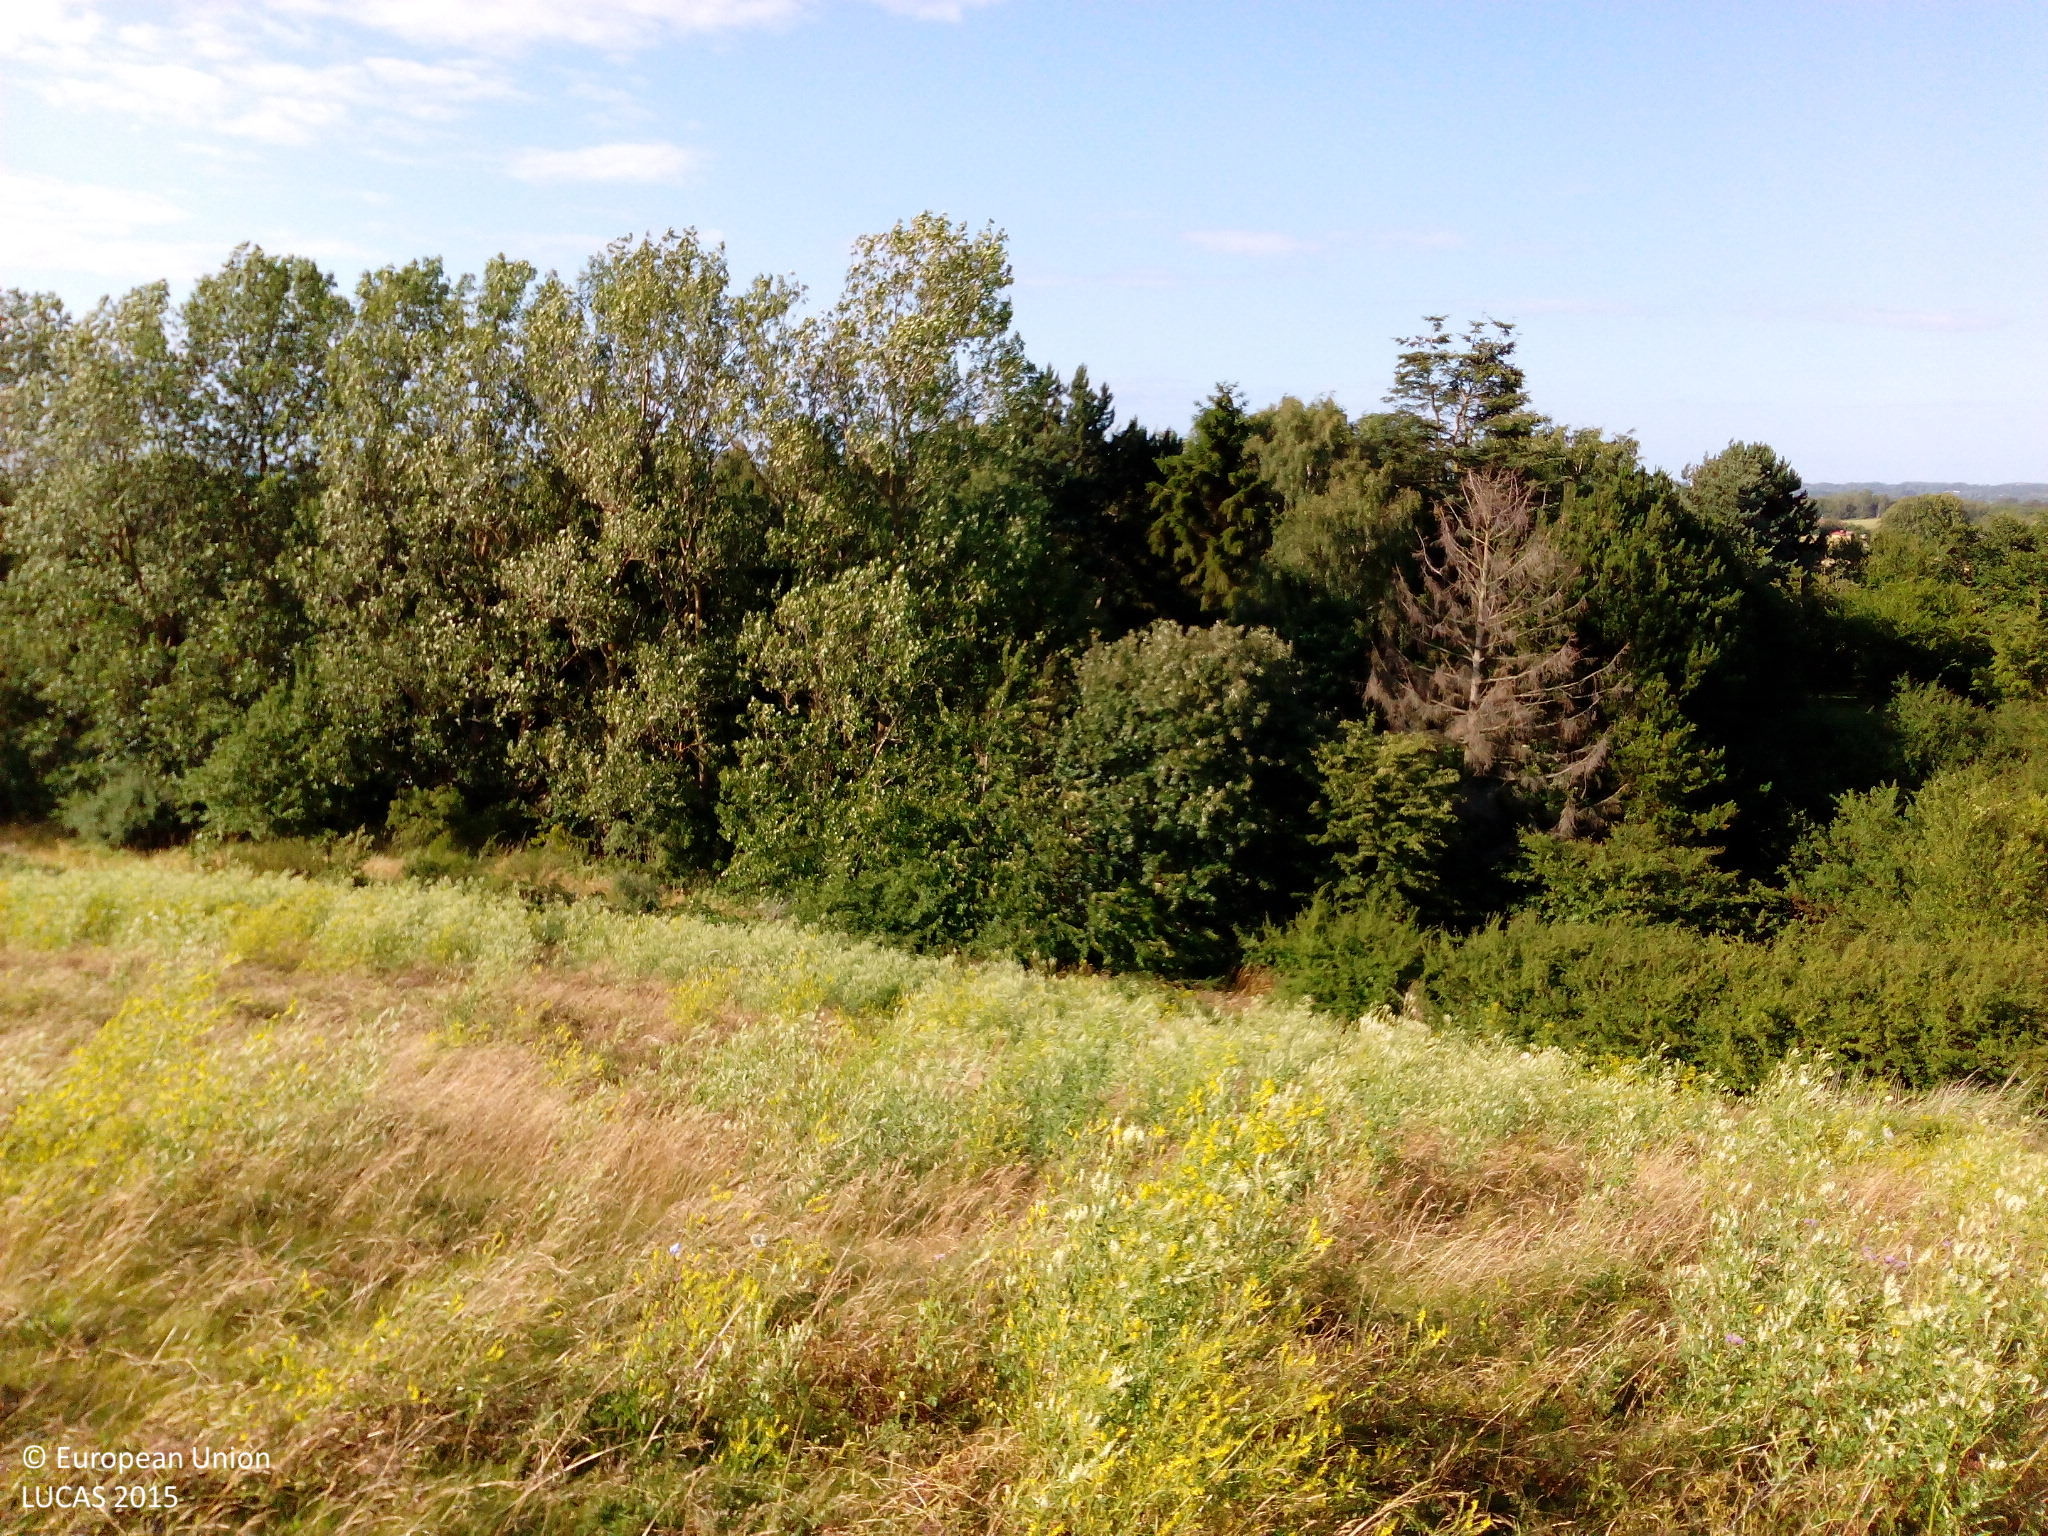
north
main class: Grassland
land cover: Spontaneously vegetated surfaces
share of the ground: > 75 %
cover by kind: herbaceous plants 100 %
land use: Fallow land
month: July
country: DK
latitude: 55.8548
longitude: 11.5480
